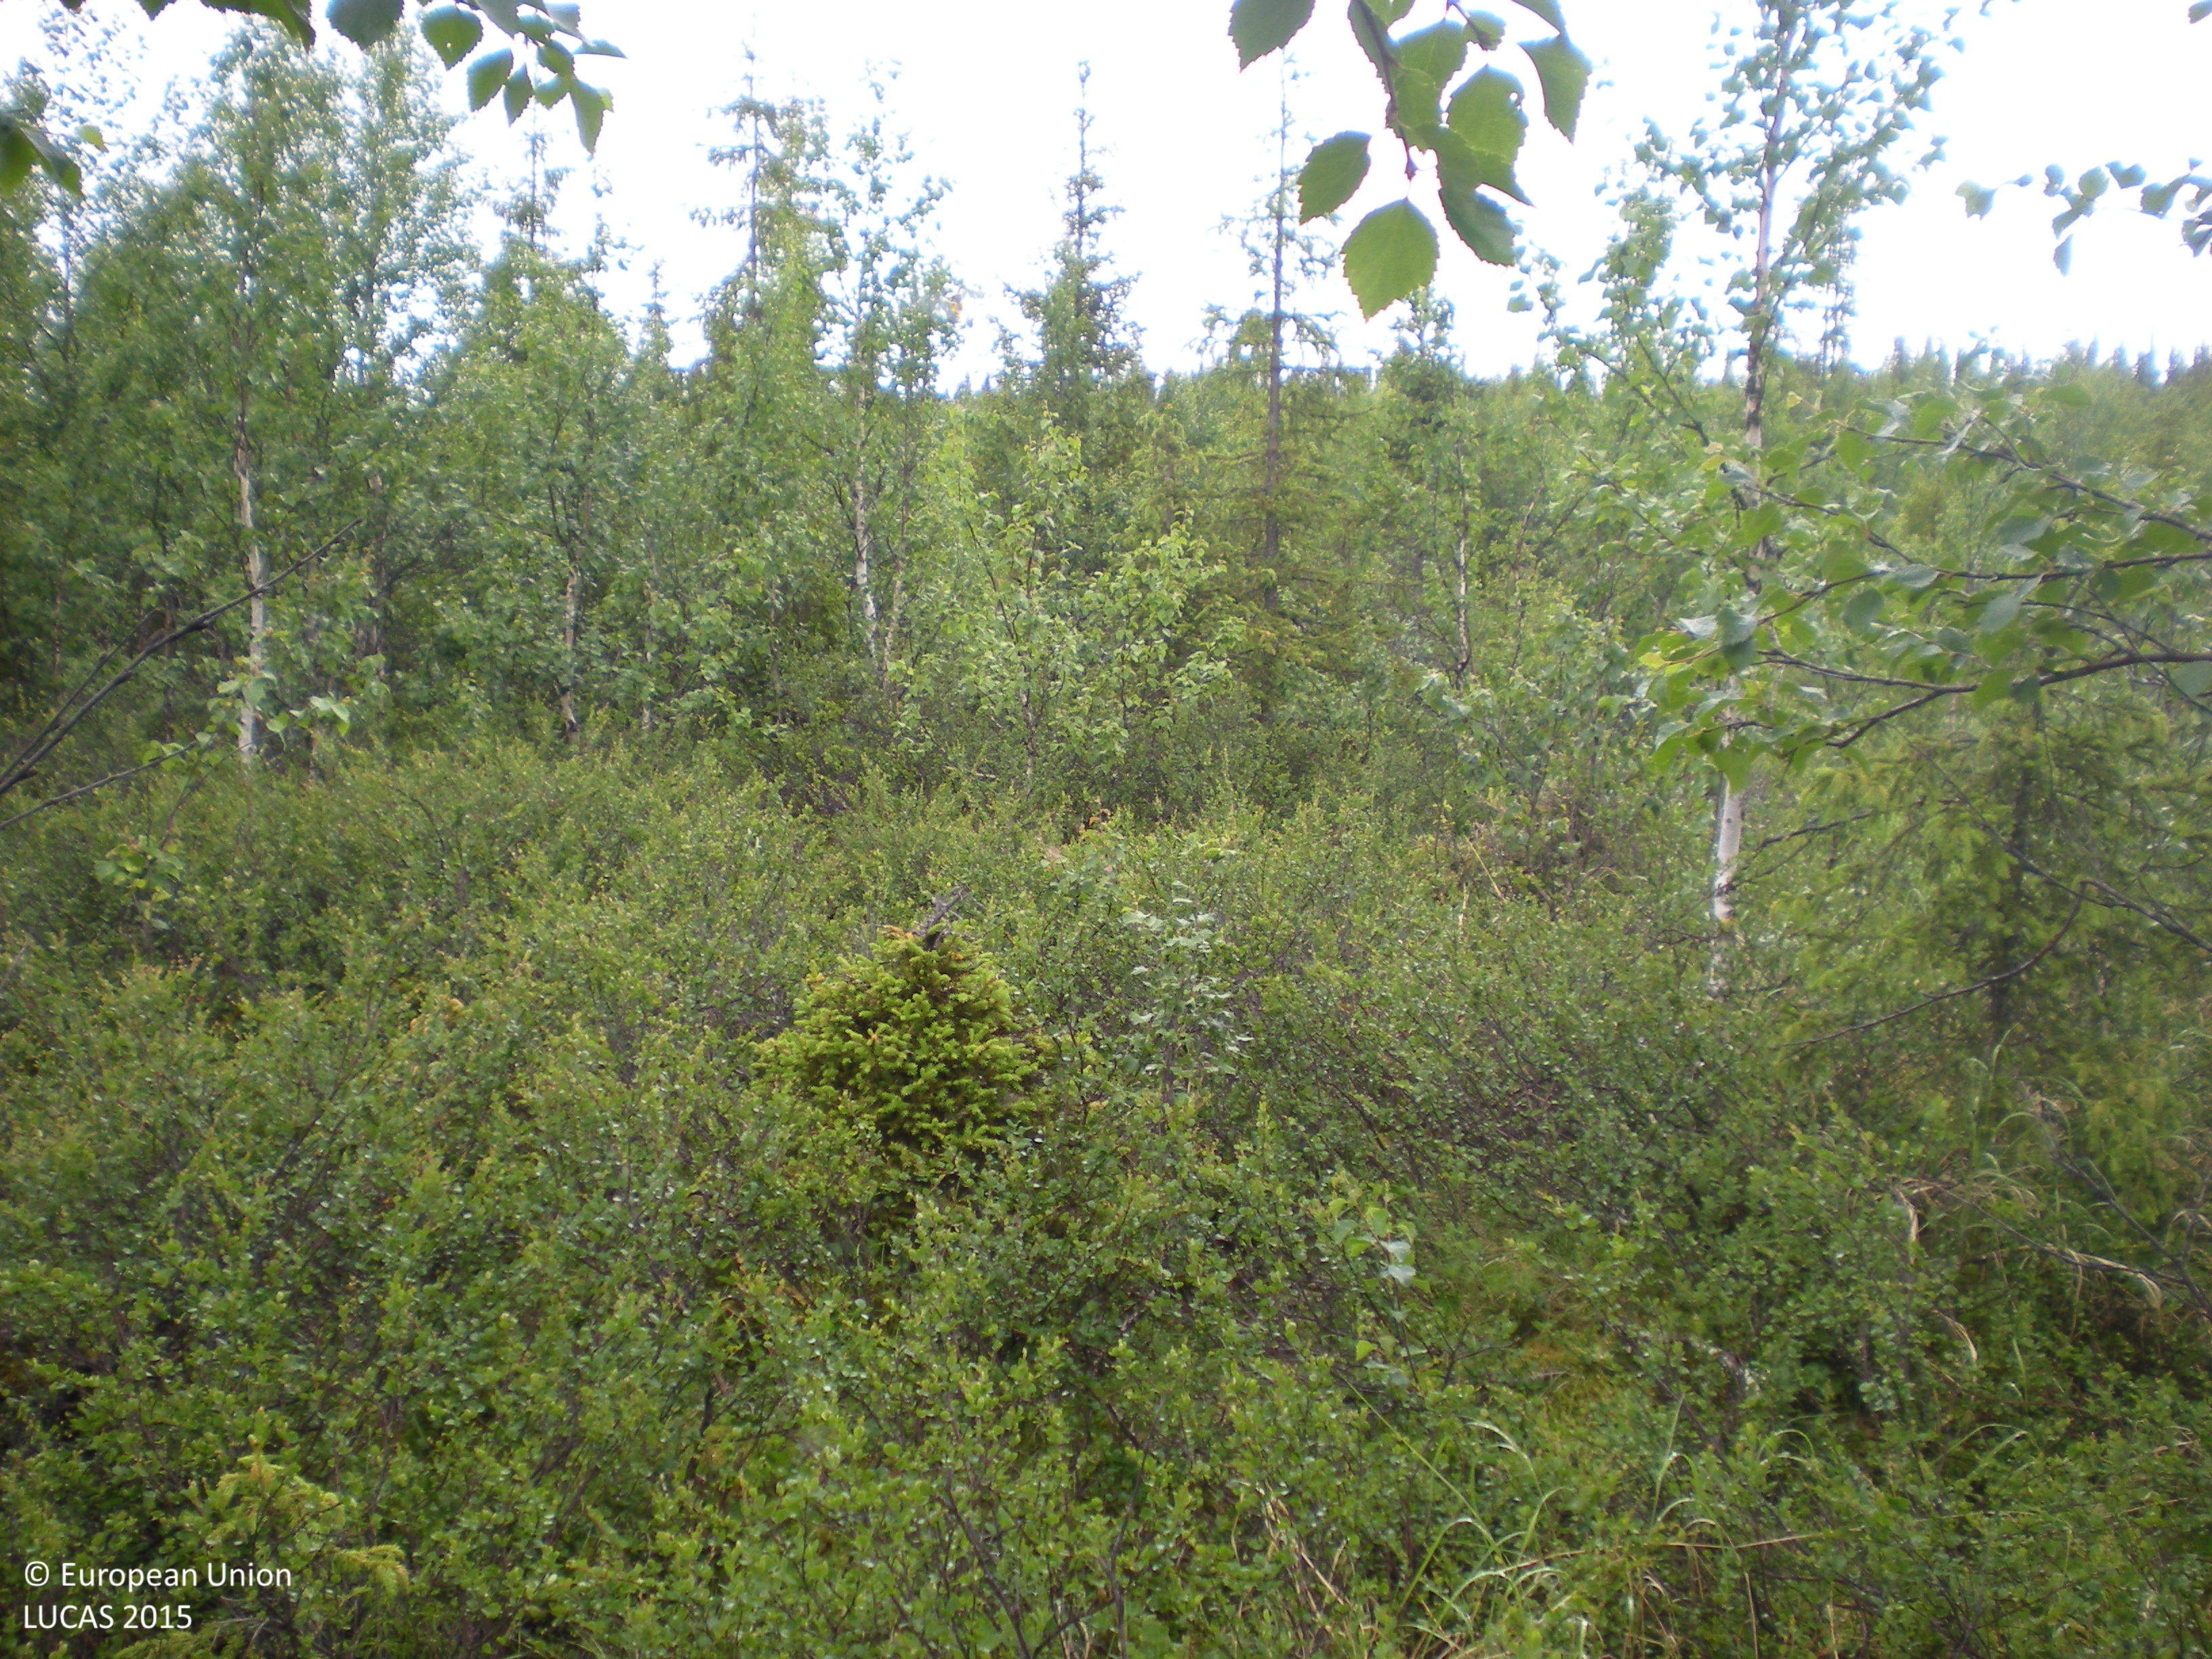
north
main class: Woodland
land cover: Spruce dominated mixed woodland
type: boreal forest
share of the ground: 50 - 75 %
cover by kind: broadleaved forest trees 55 %, coniferous forest trees 20 %, herbaceous plants 10 %, lichens and mosses 10 %, shrubs 5 %
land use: Forestry
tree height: > 5 m
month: July
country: SE
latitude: 65.7765
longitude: 17.2315
